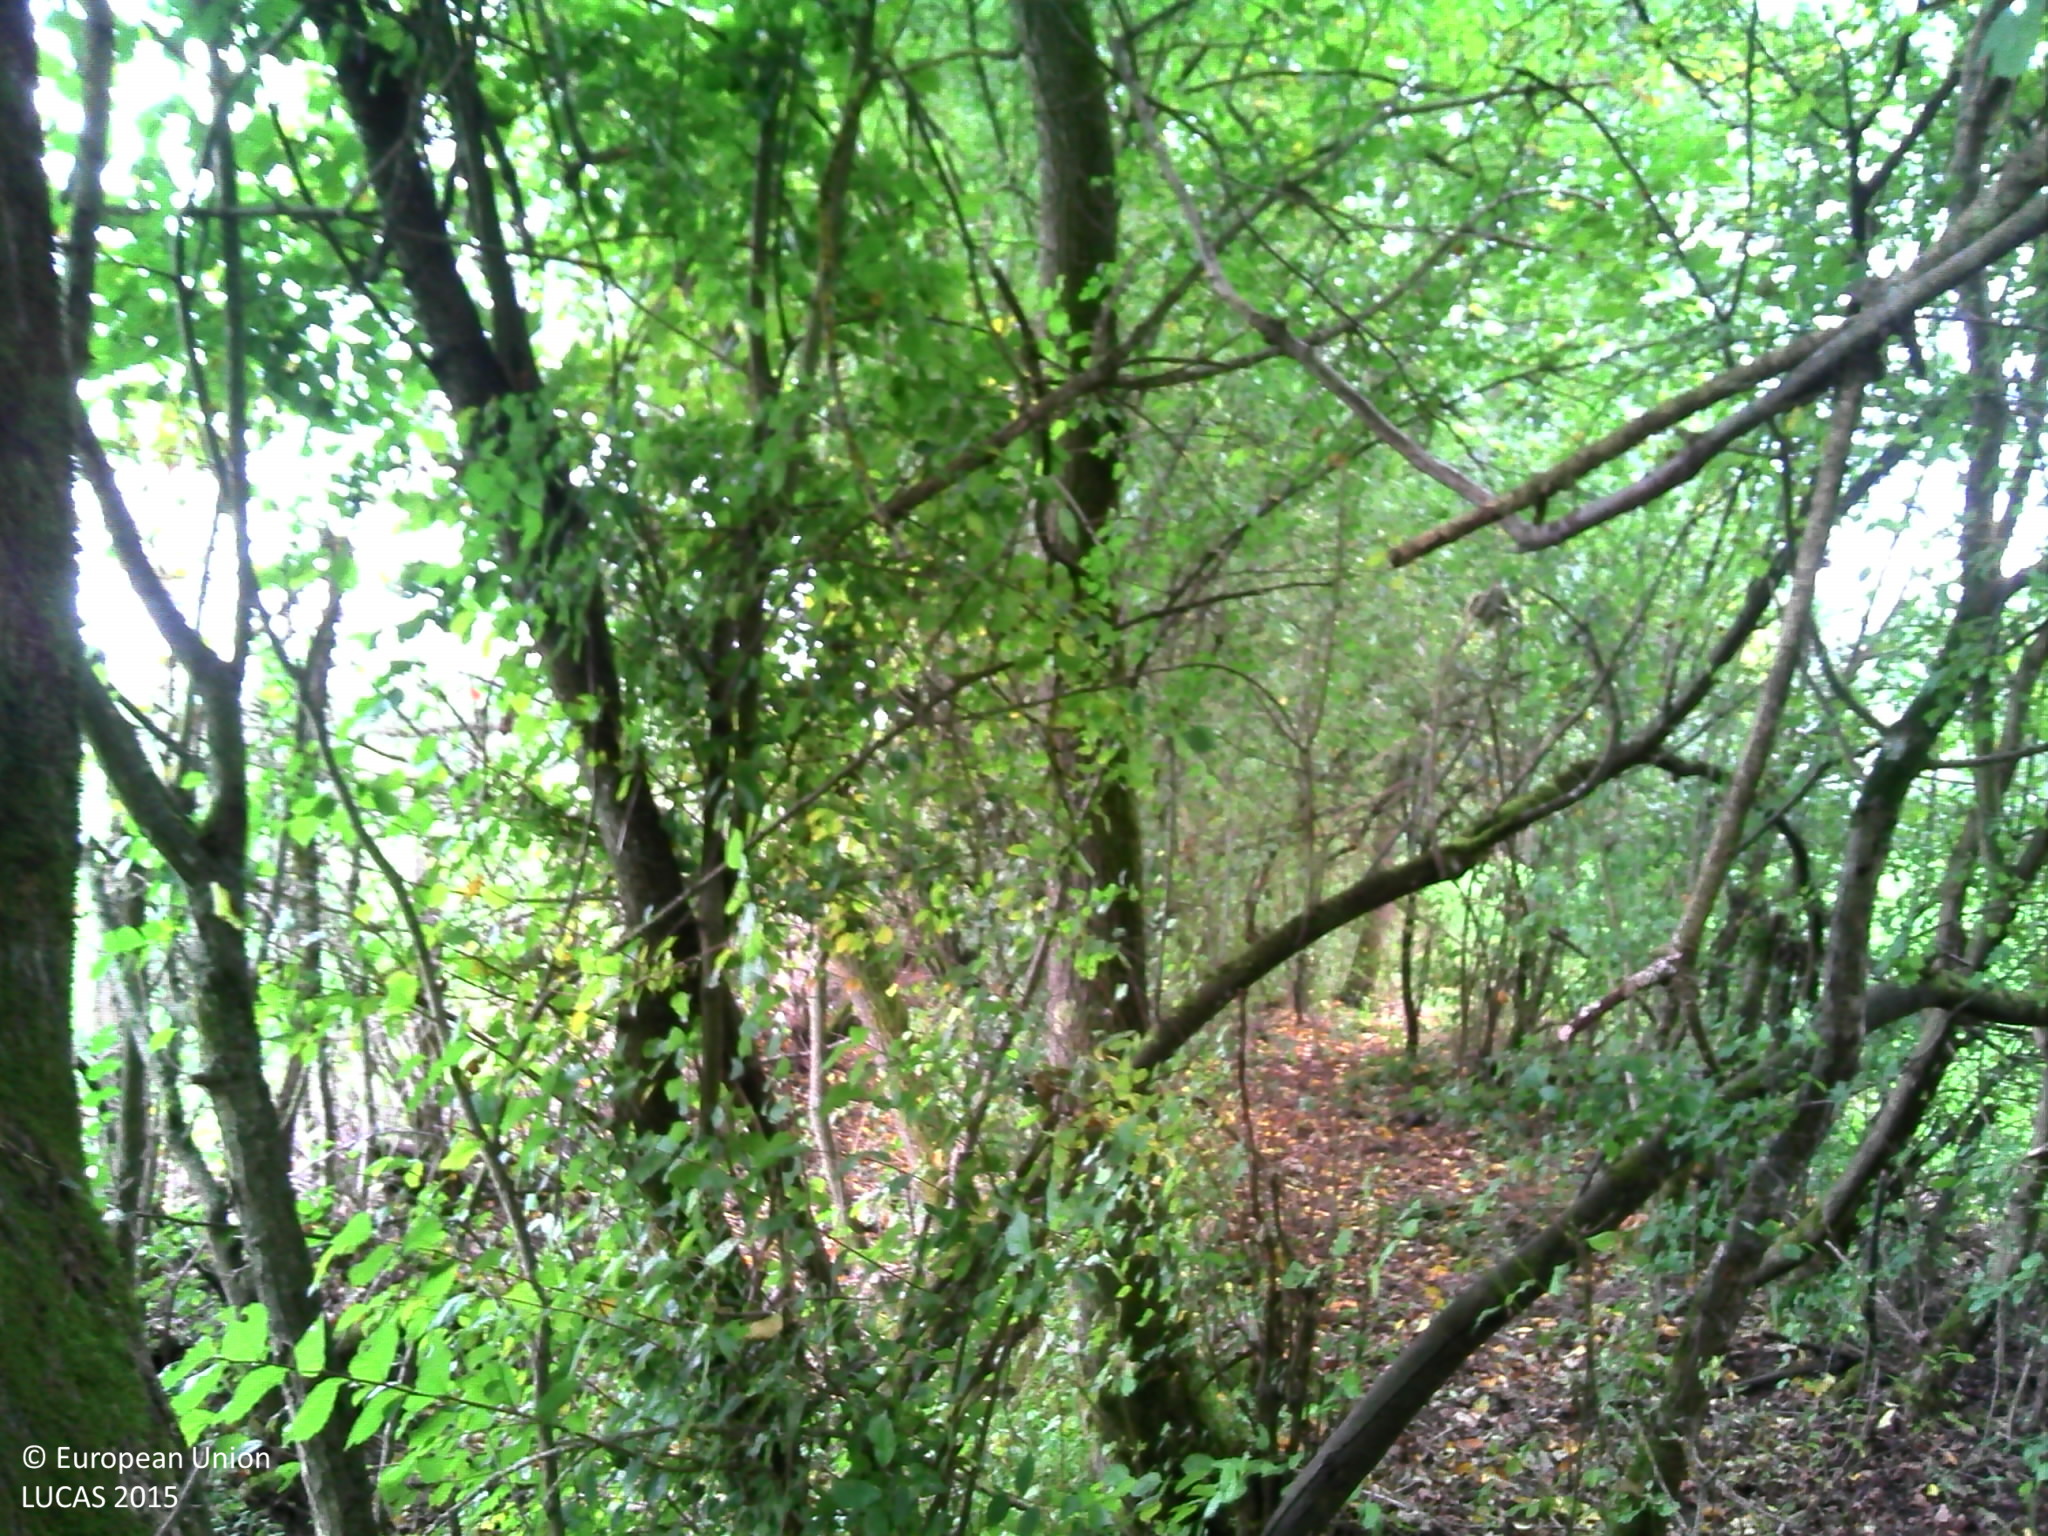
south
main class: Woodland
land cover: Broadleaved woodland
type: mesophytic deciduous forest
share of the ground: > 75 %
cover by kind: broadleaved forest trees 90 %, shrubs 10 %
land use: Forestry
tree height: > 5 m
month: October
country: FR
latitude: 46.5031
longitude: 4.9591
